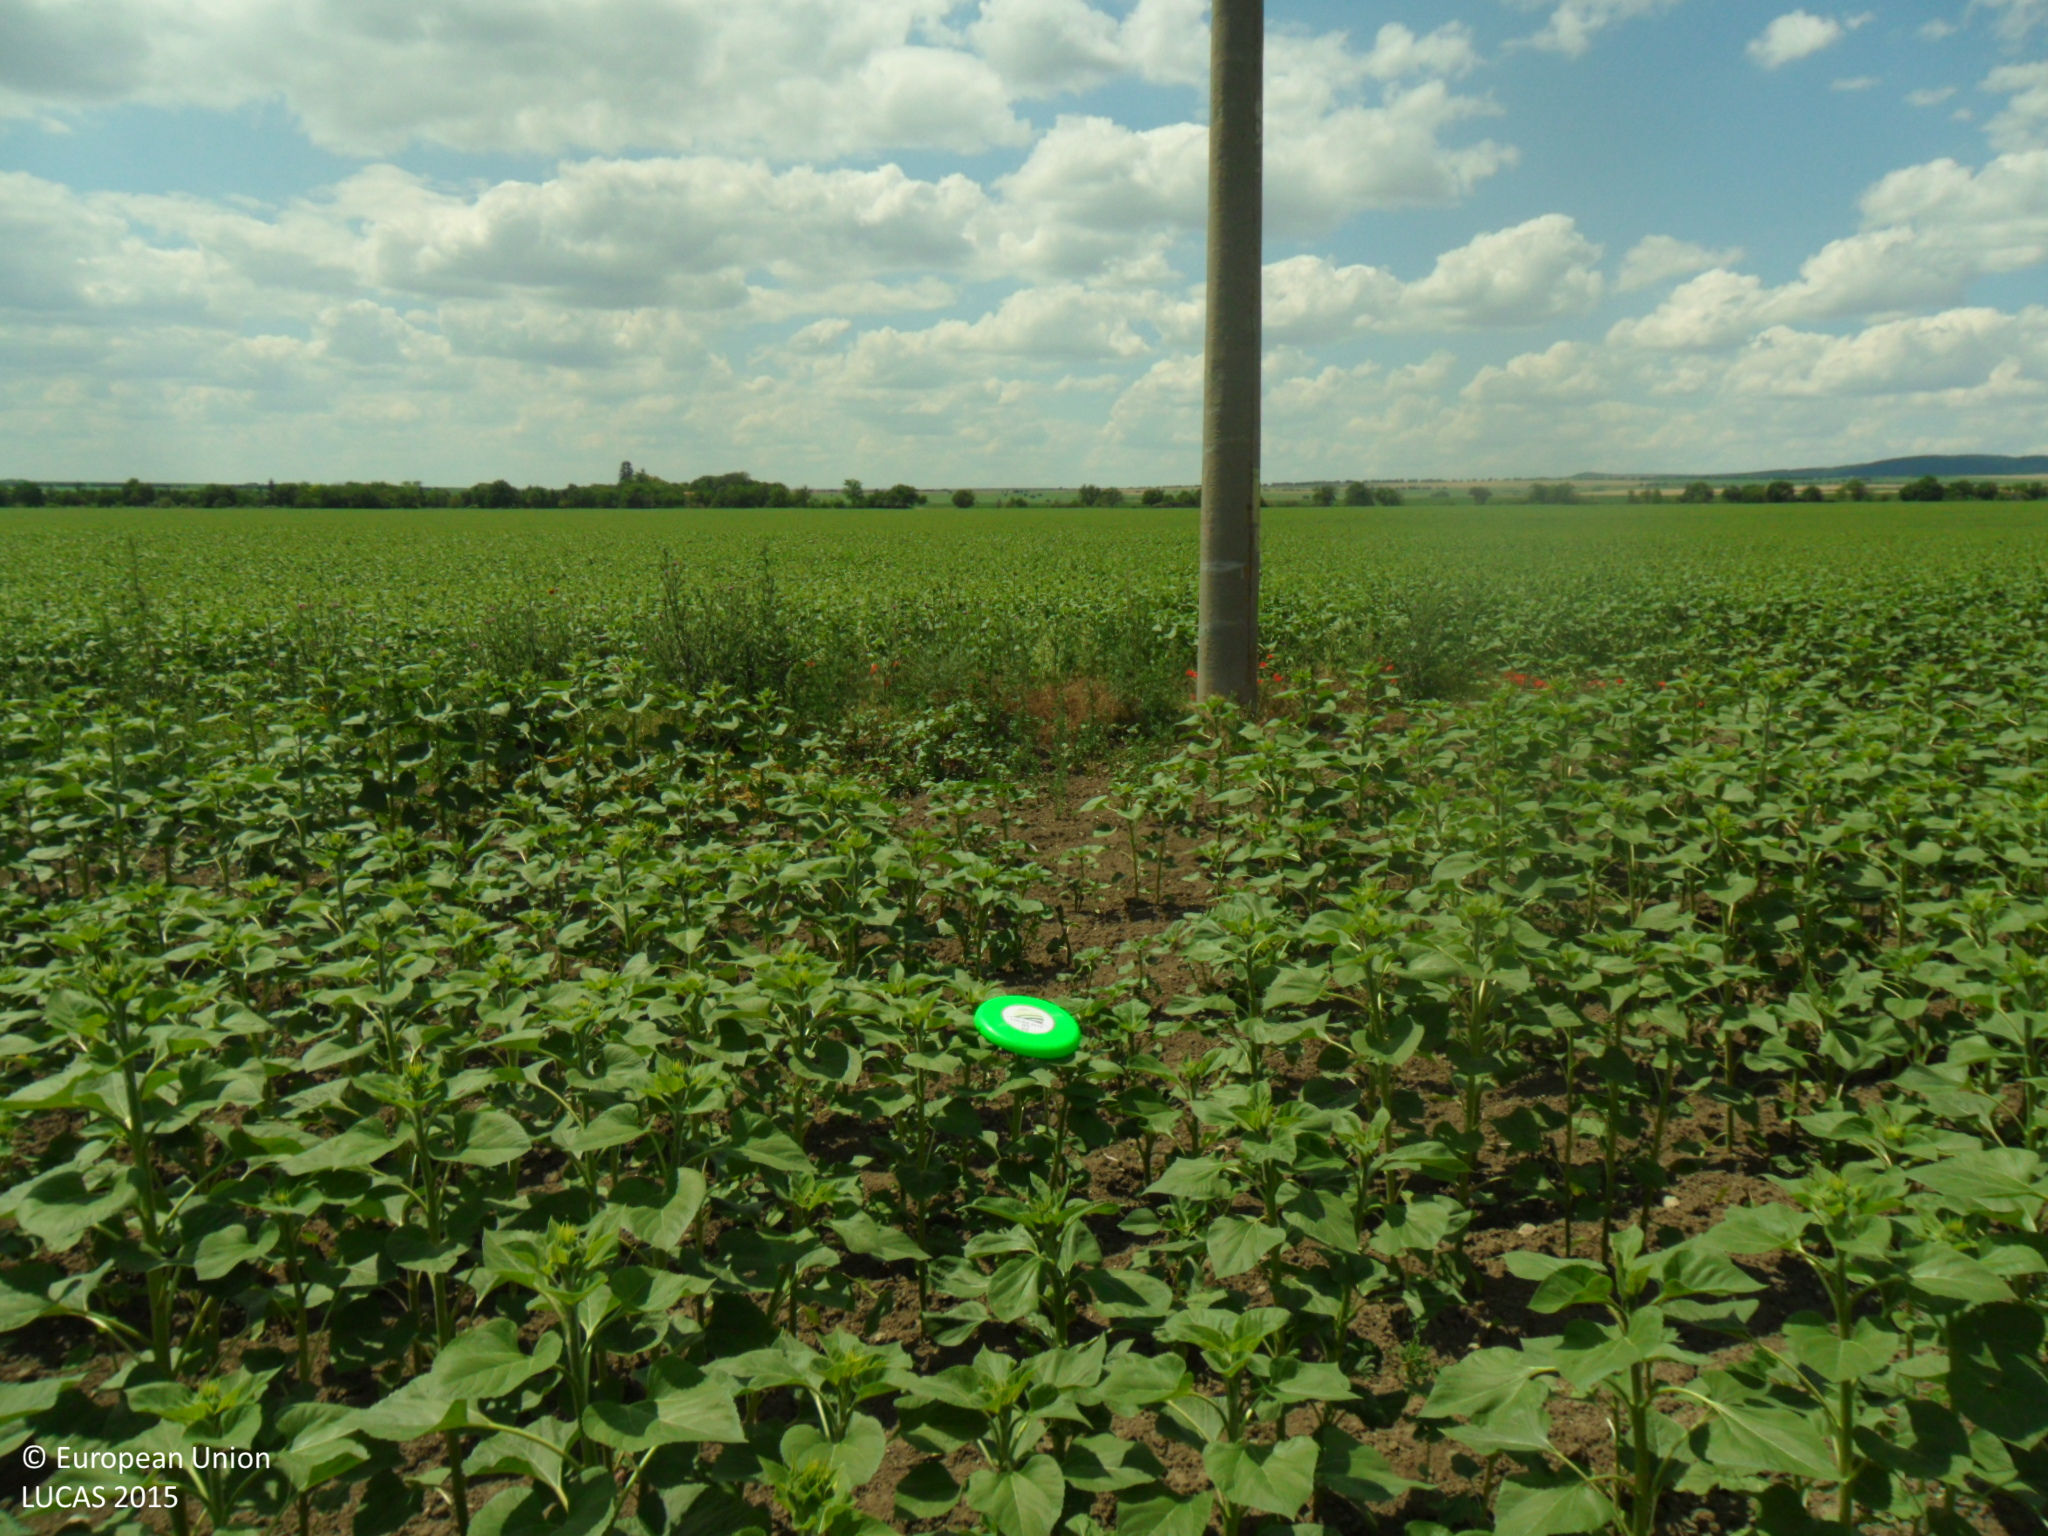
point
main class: Cropland
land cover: Sunflower
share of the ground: > 75 %
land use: Agriculture (excluding fallow land and kitchen gardens)
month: June
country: BG
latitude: 43.3894
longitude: 27.1436
